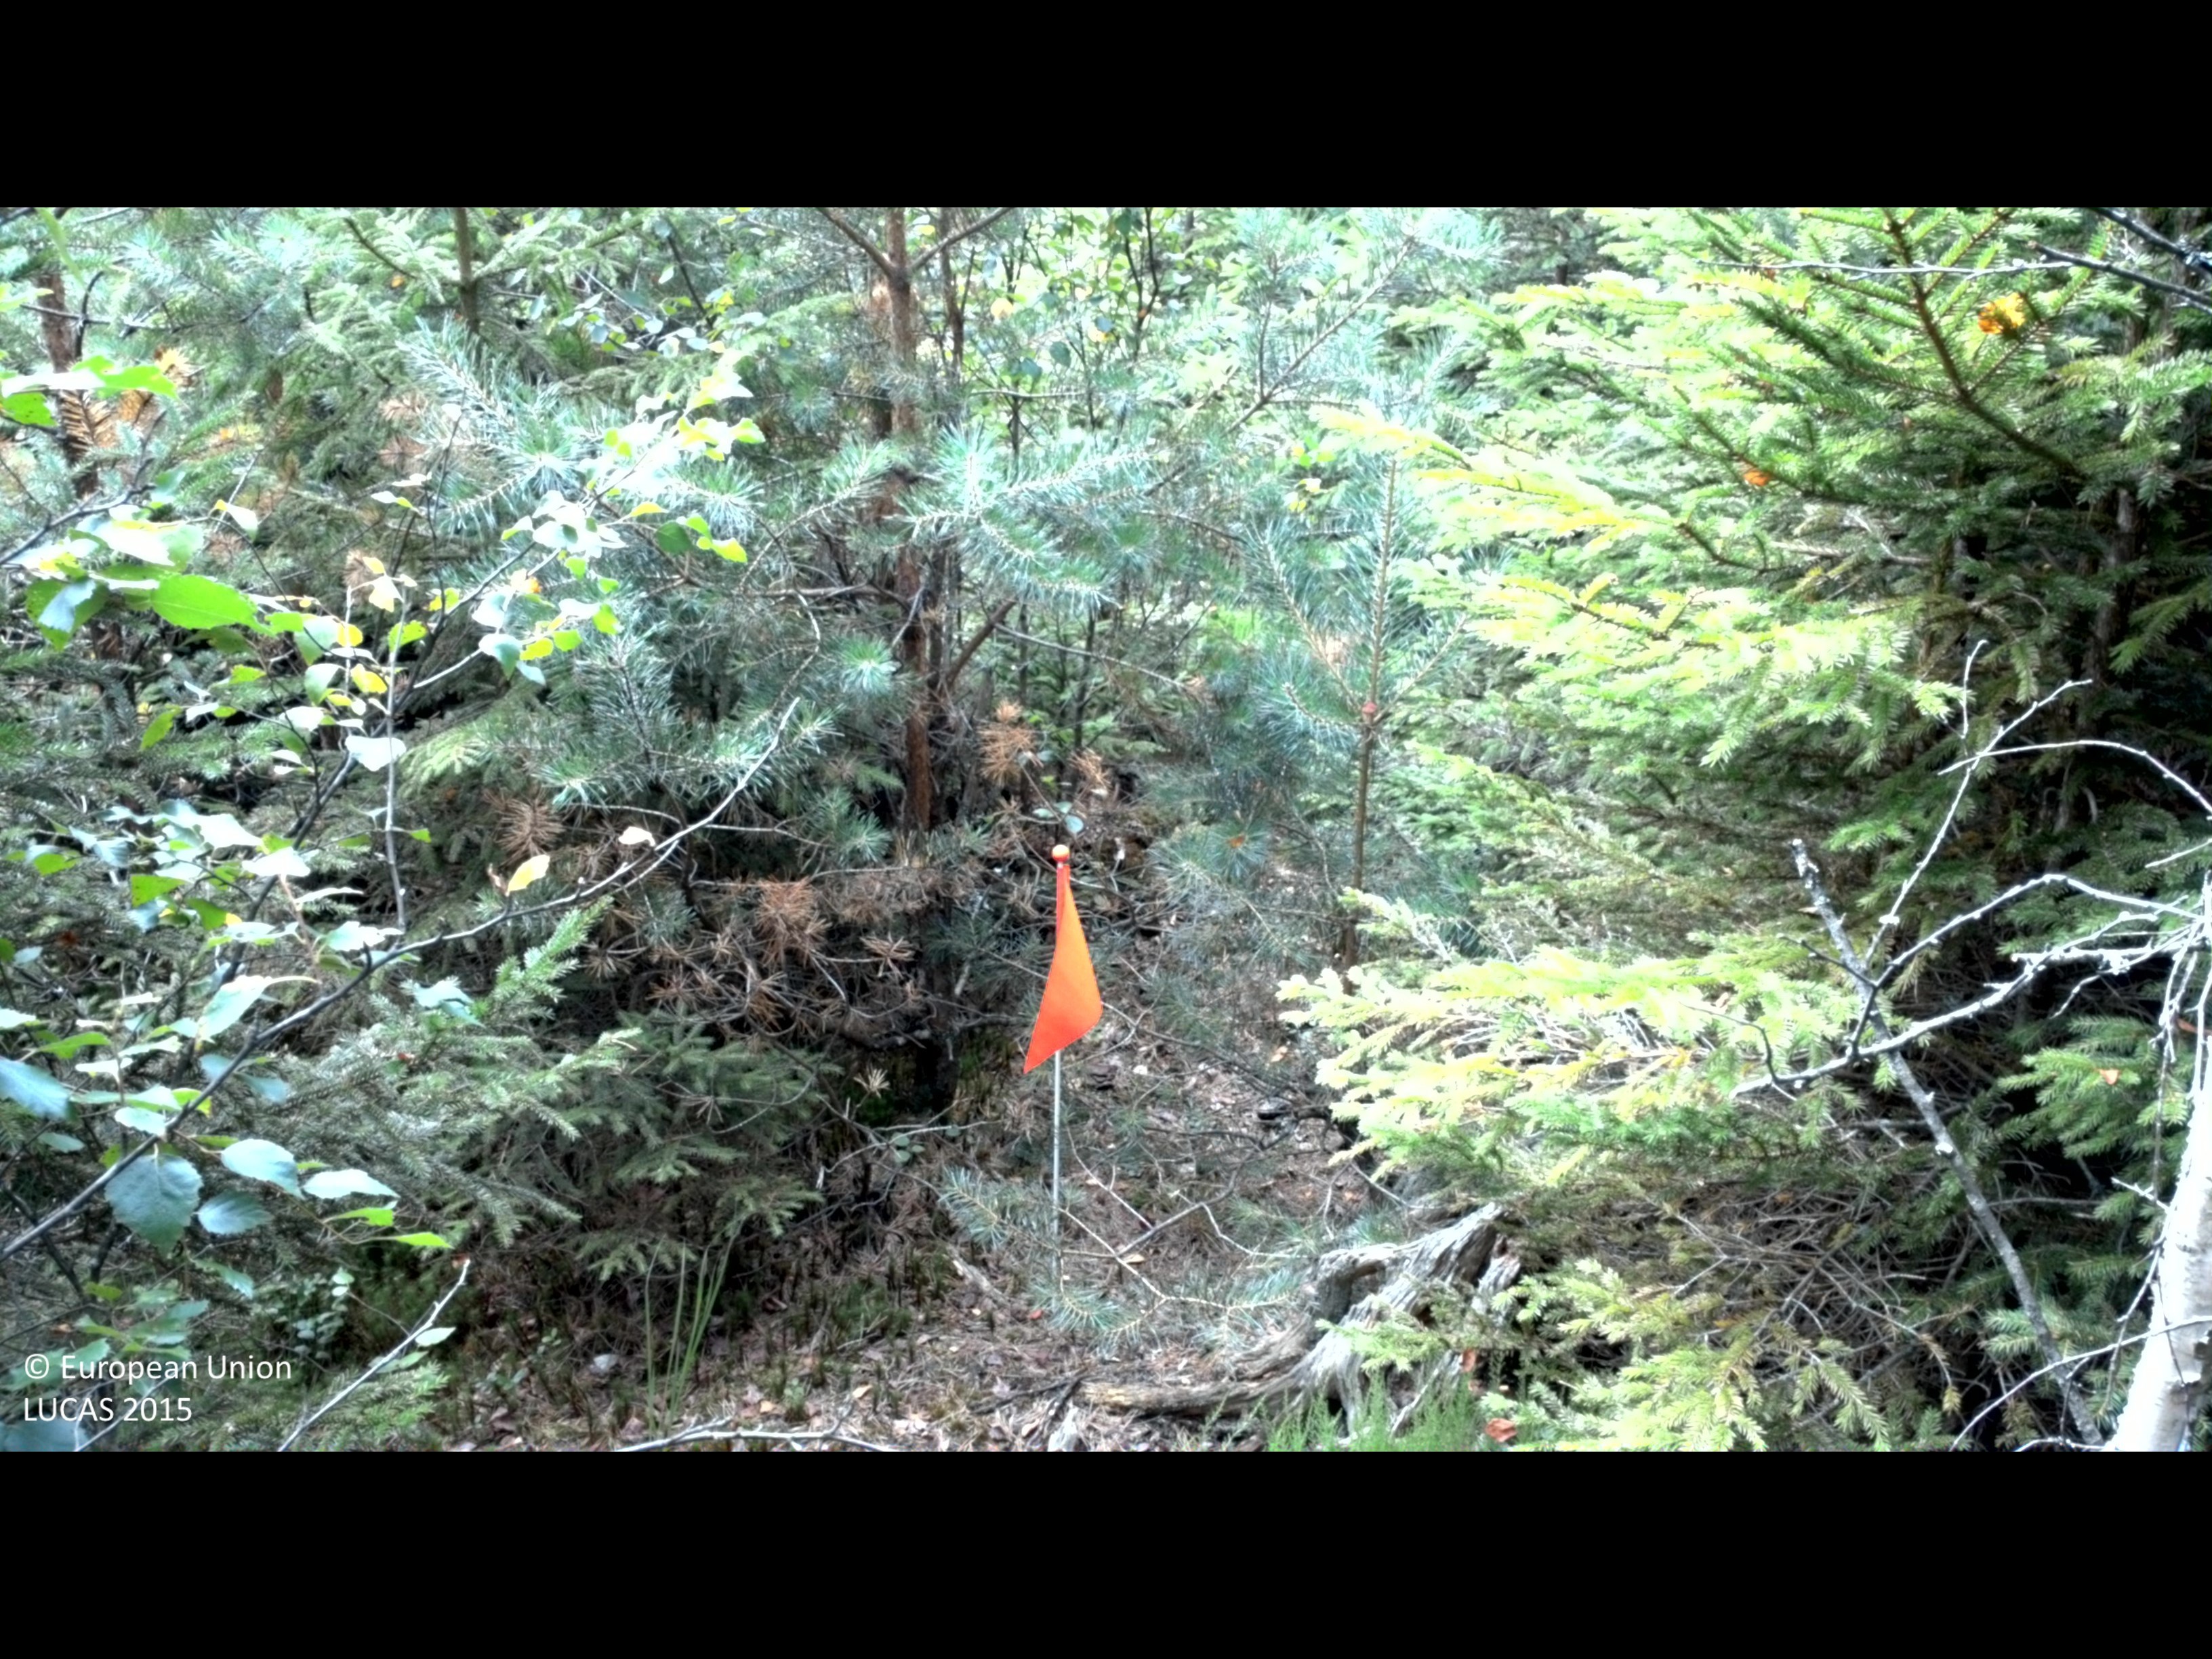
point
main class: Woodland
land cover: Spruce dominated mixed woodland
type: boreal forest
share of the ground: > 75 %
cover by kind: broadleaved forest trees 50 %, coniferous forest trees 40 %, herbaceous plants 10 %
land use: Forestry
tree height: > 5 m
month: August
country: SE
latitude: 56.9058
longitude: 13.7897
